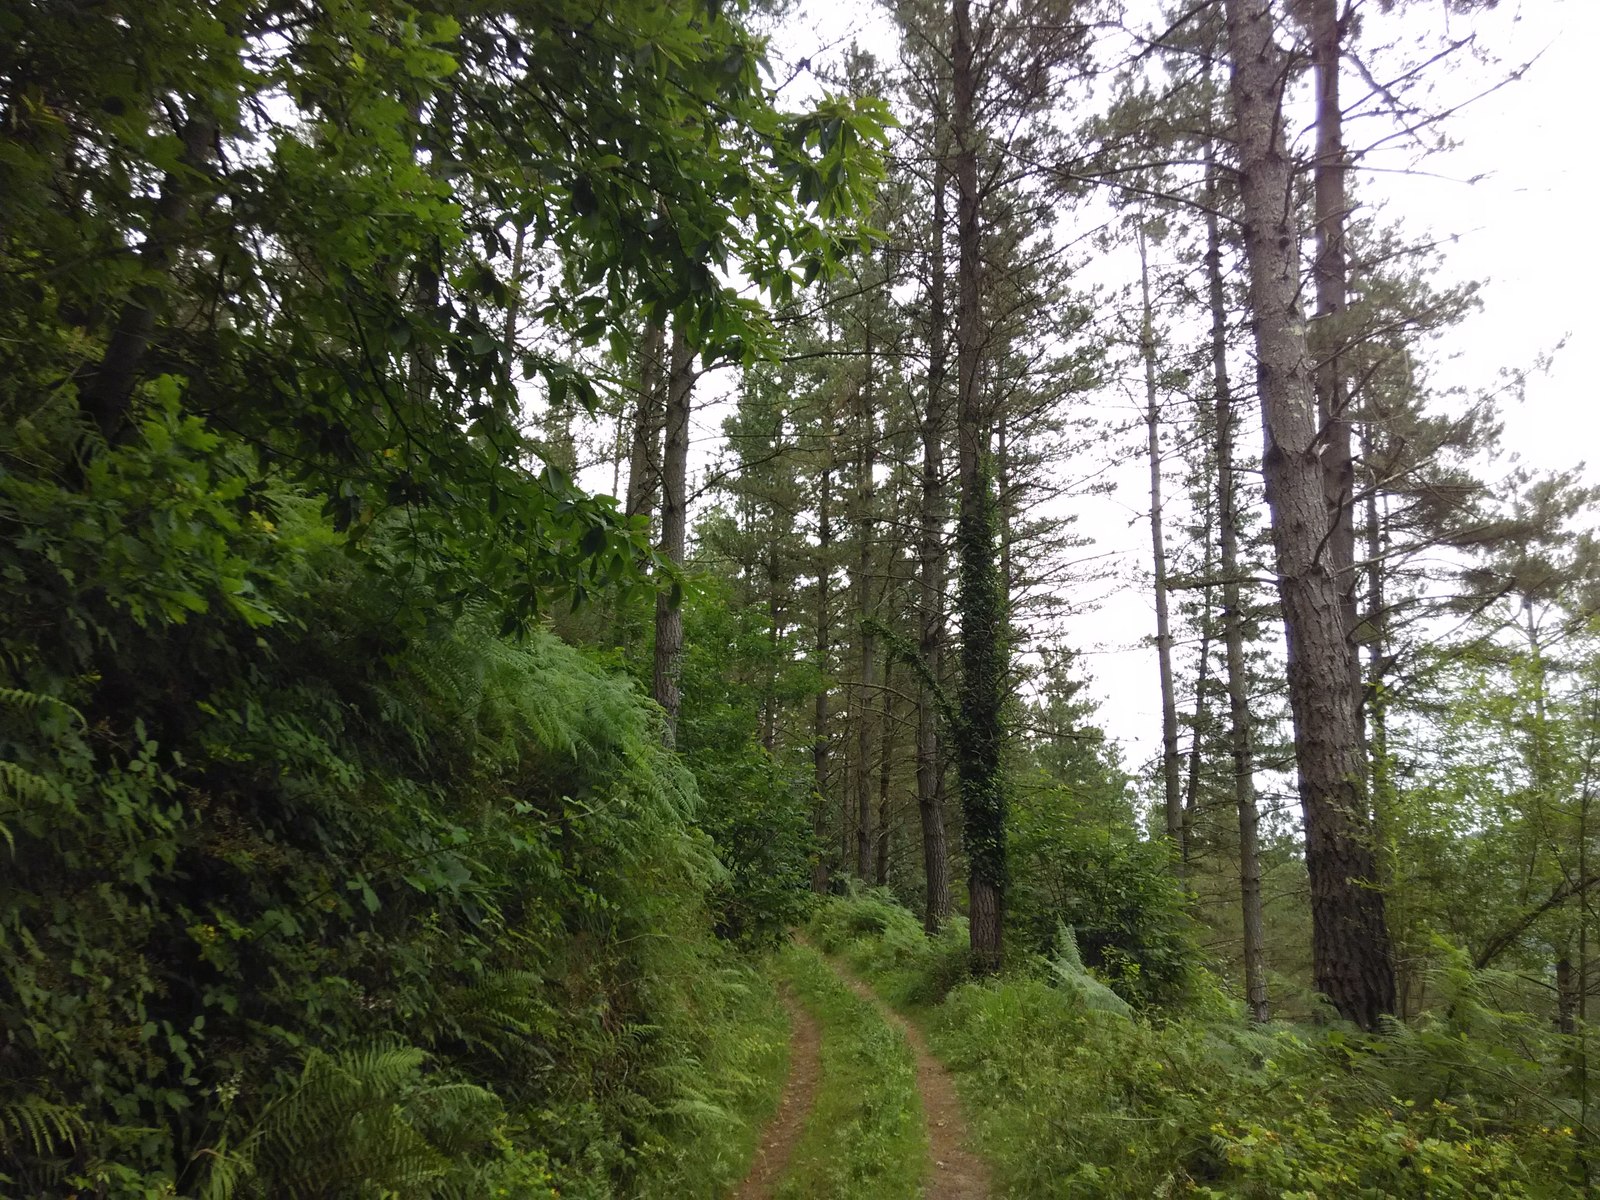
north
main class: Woodland
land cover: Pine dominated coniferous woodland
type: exotic forest
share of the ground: > 75 %
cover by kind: coniferous forest trees 100 %
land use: Forestry
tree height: > 5 m
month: July
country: ES
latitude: 43.1793
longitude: -2.4401
